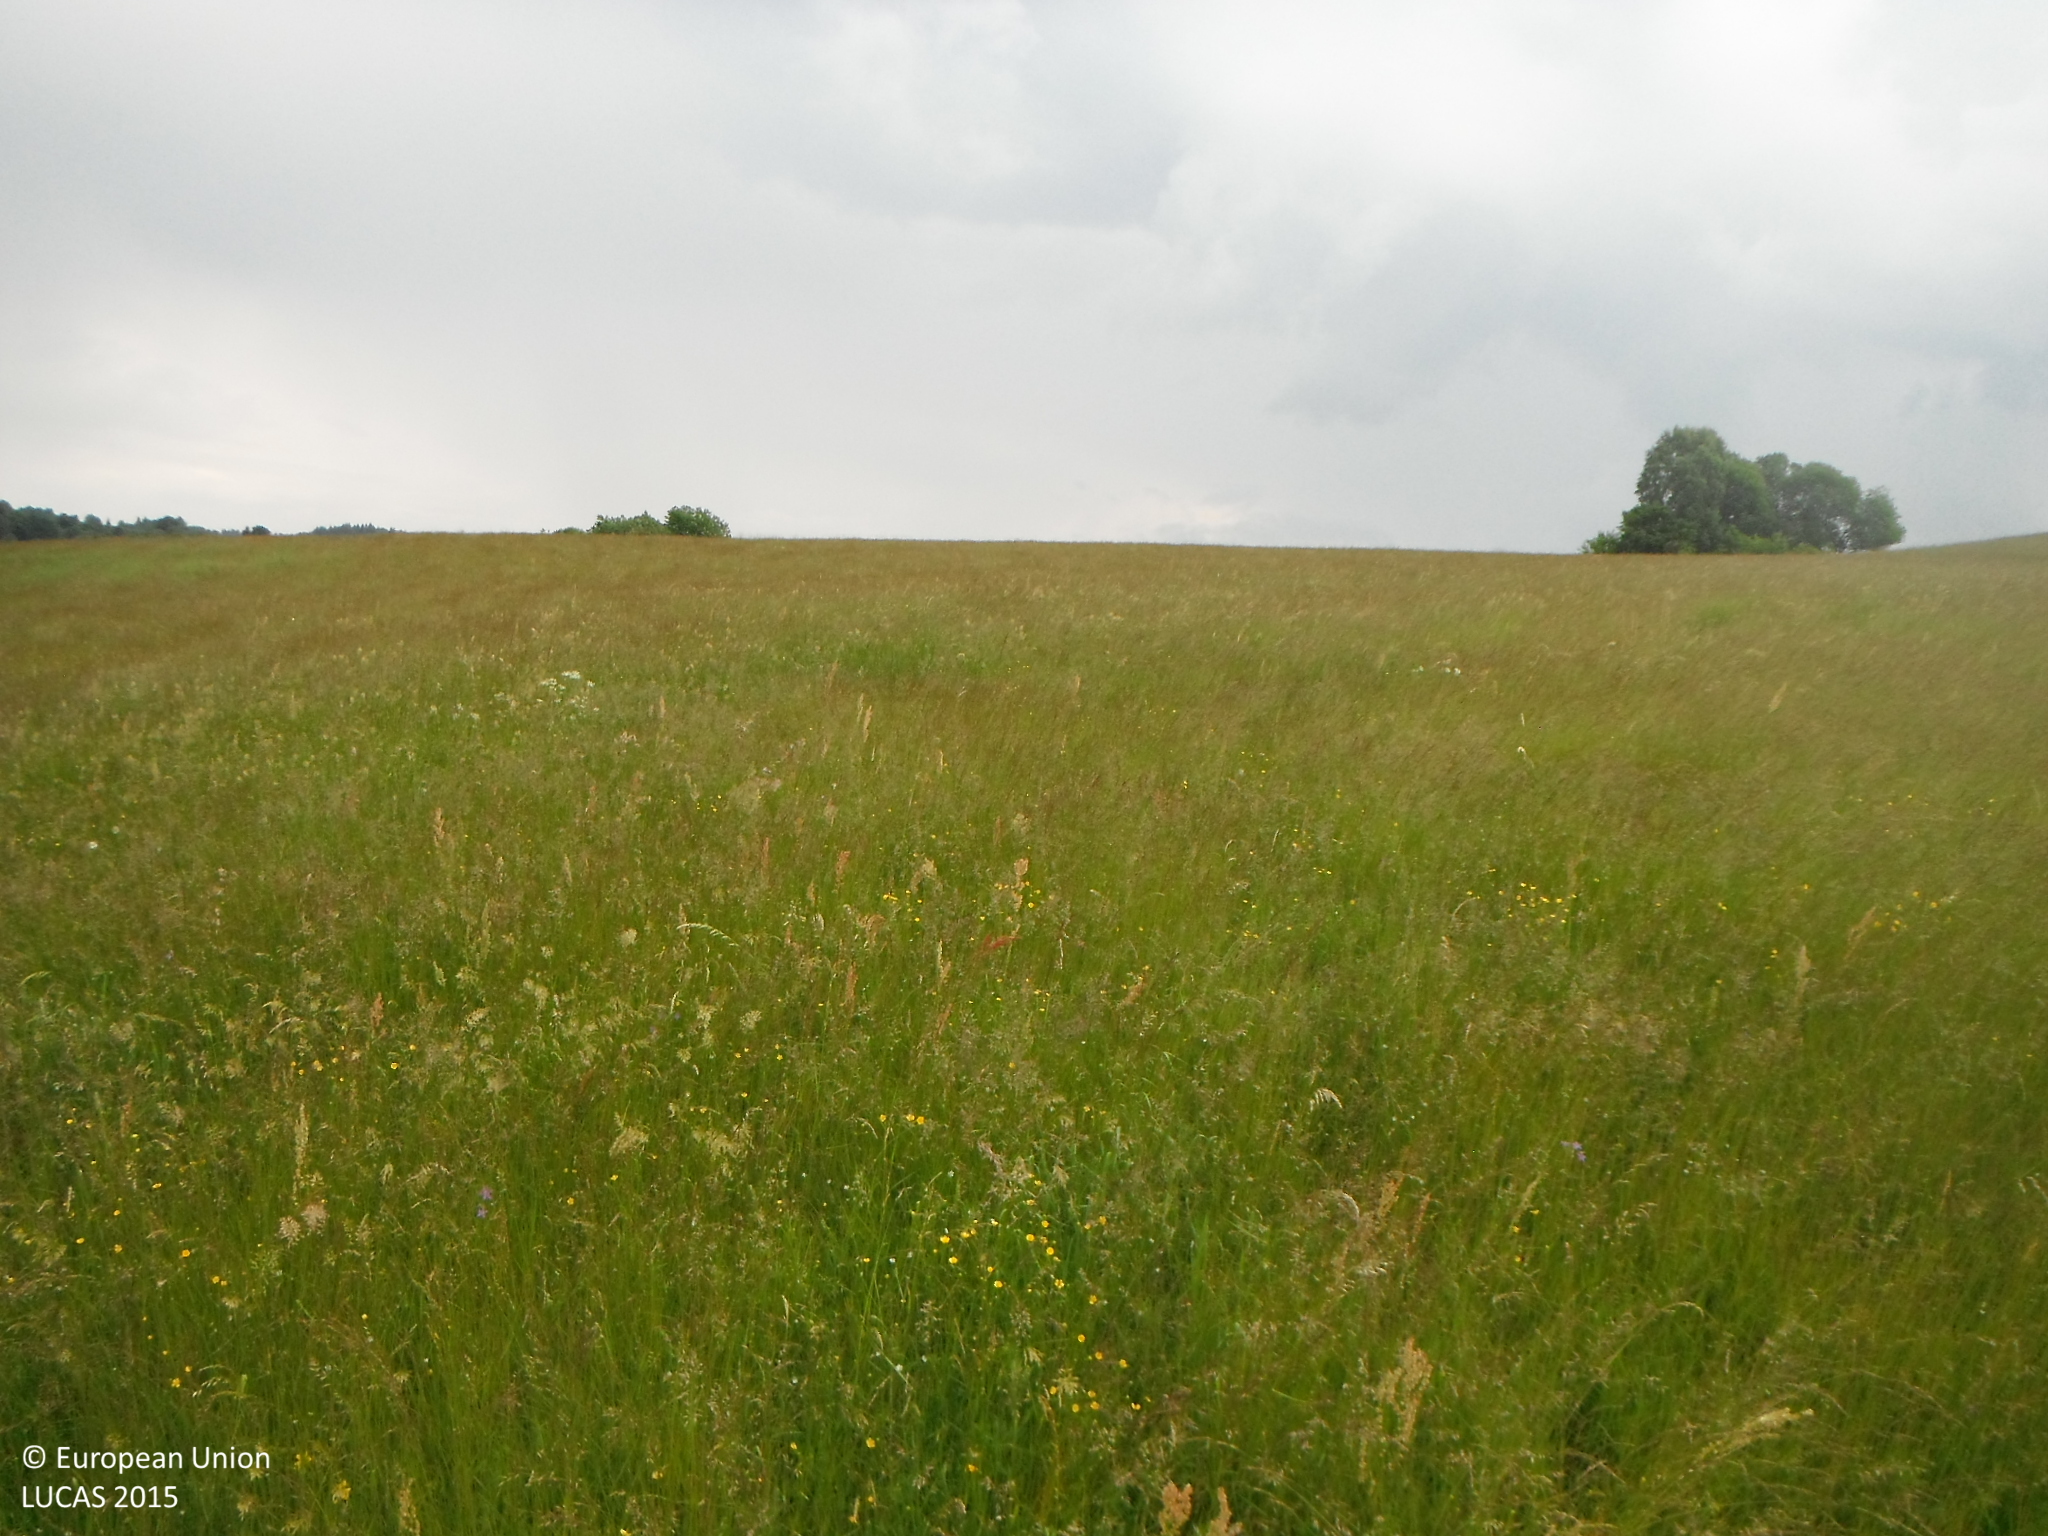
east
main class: Grassland
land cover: Grassland without tree/shrub cover
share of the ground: > 75 %
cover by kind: herbaceous plants 100 %
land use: Agriculture (excluding fallow land and kitchen gardens)
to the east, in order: Grassland without tree/shrub cover
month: June
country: SK
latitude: 48.6763
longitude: 19.3540
